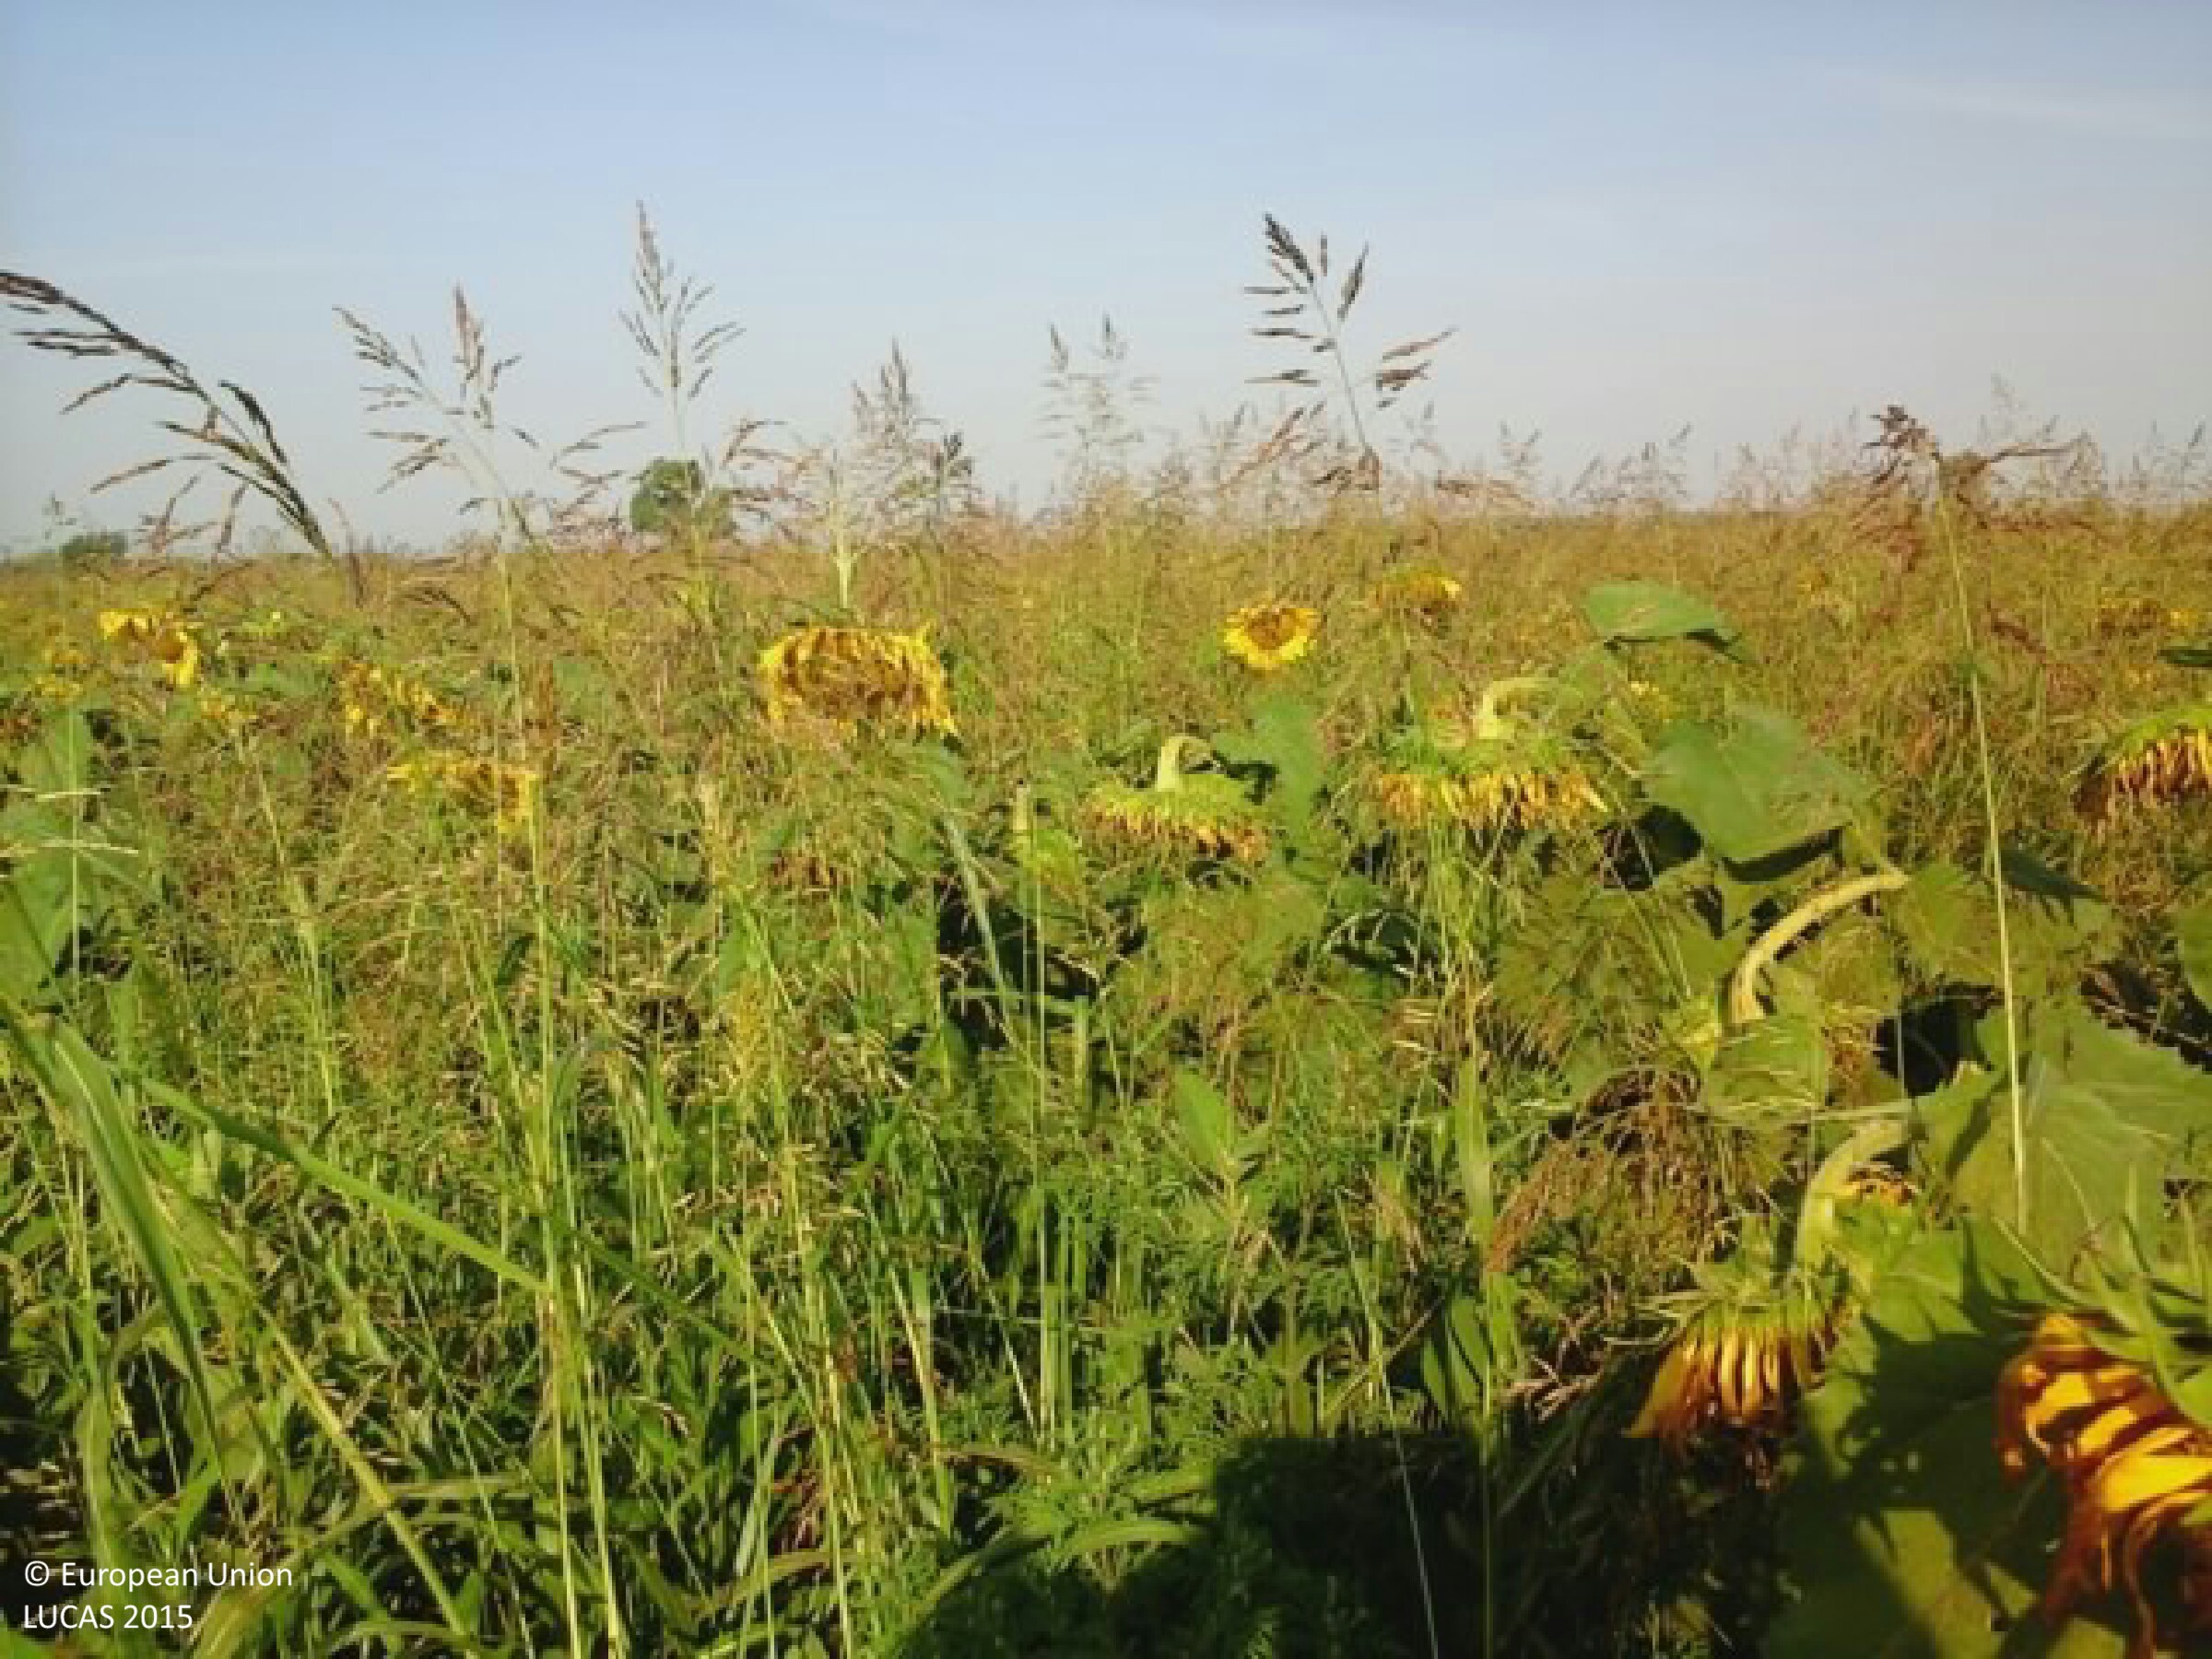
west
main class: Cropland
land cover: Sunflower
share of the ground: > 75 %
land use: Agriculture (excluding fallow land and kitchen gardens)
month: August
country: HU
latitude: 47.3051
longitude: 19.0774
